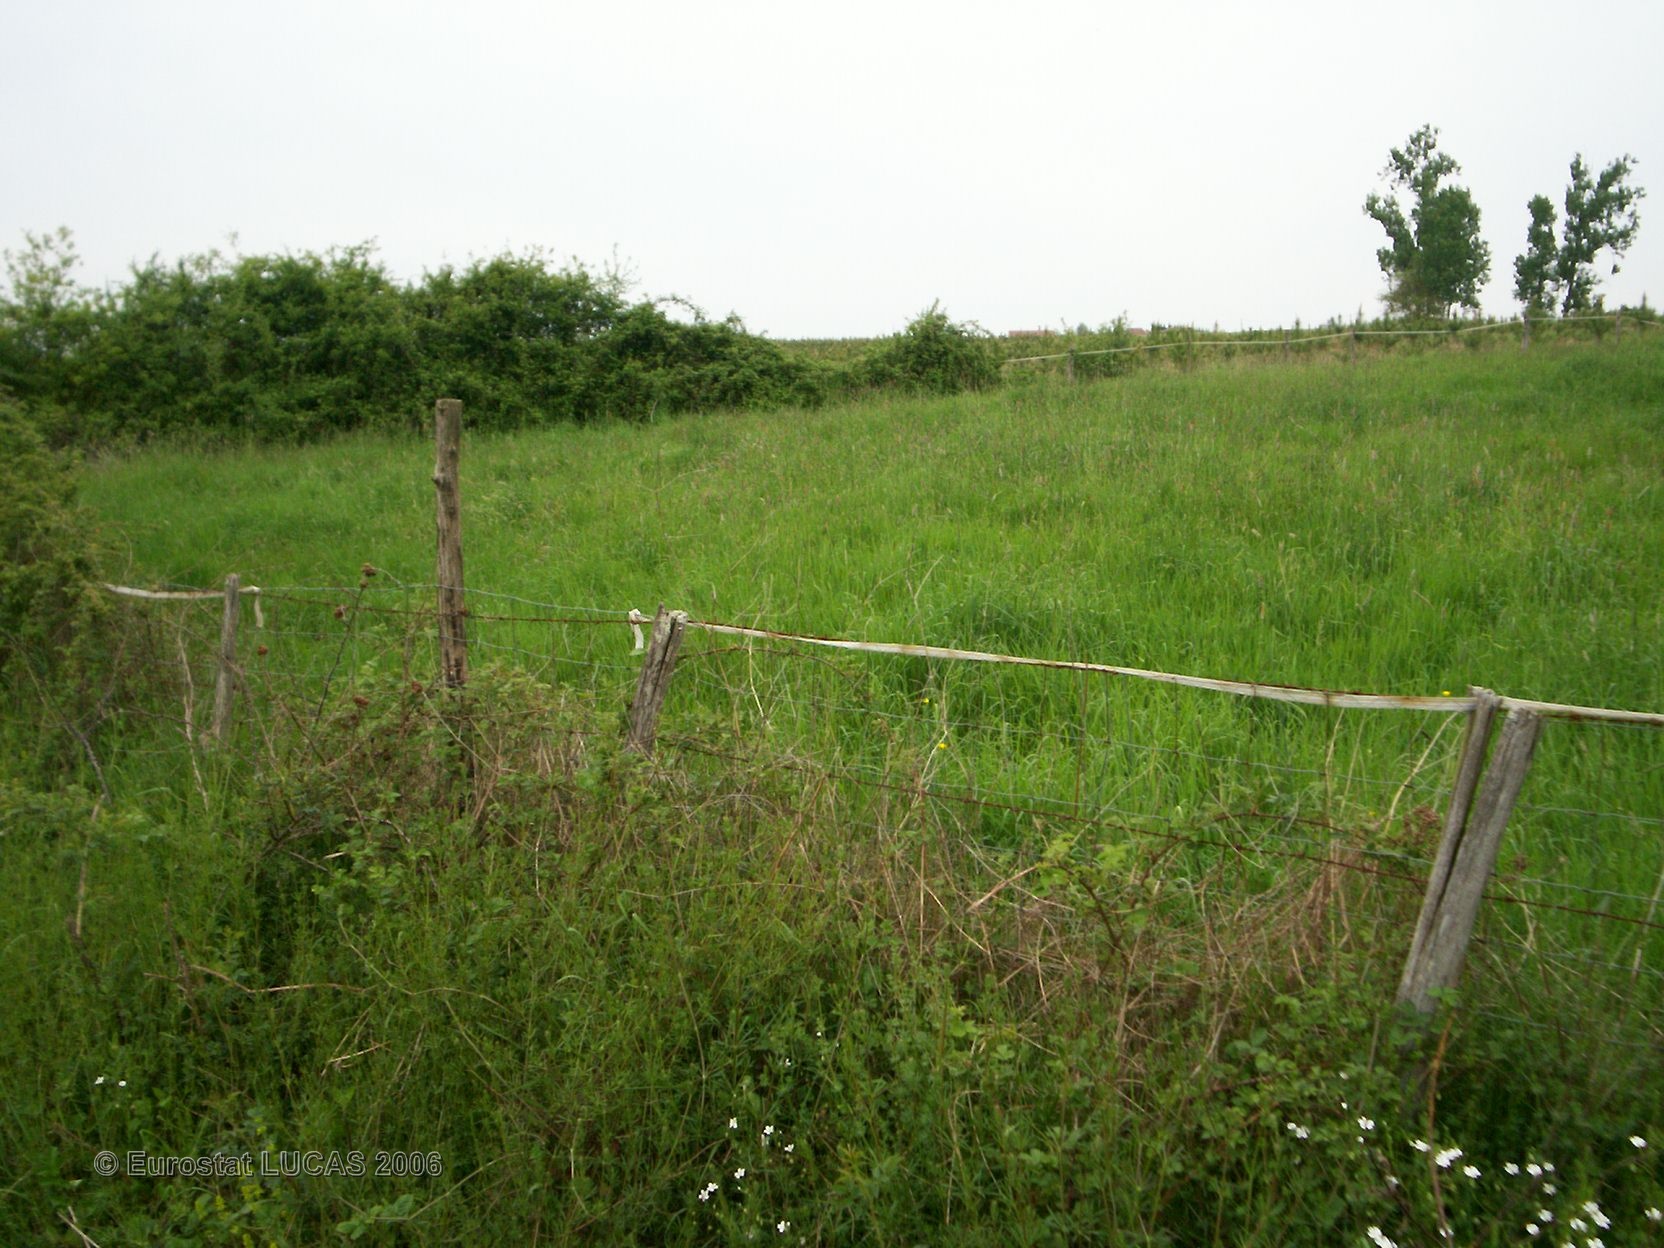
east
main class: Grassland
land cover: Grassland without tree/shrub cover
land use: Agriculture (excluding fallow land and kitchen gardens)
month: May
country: FR
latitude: 47.5768
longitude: 0.4992
